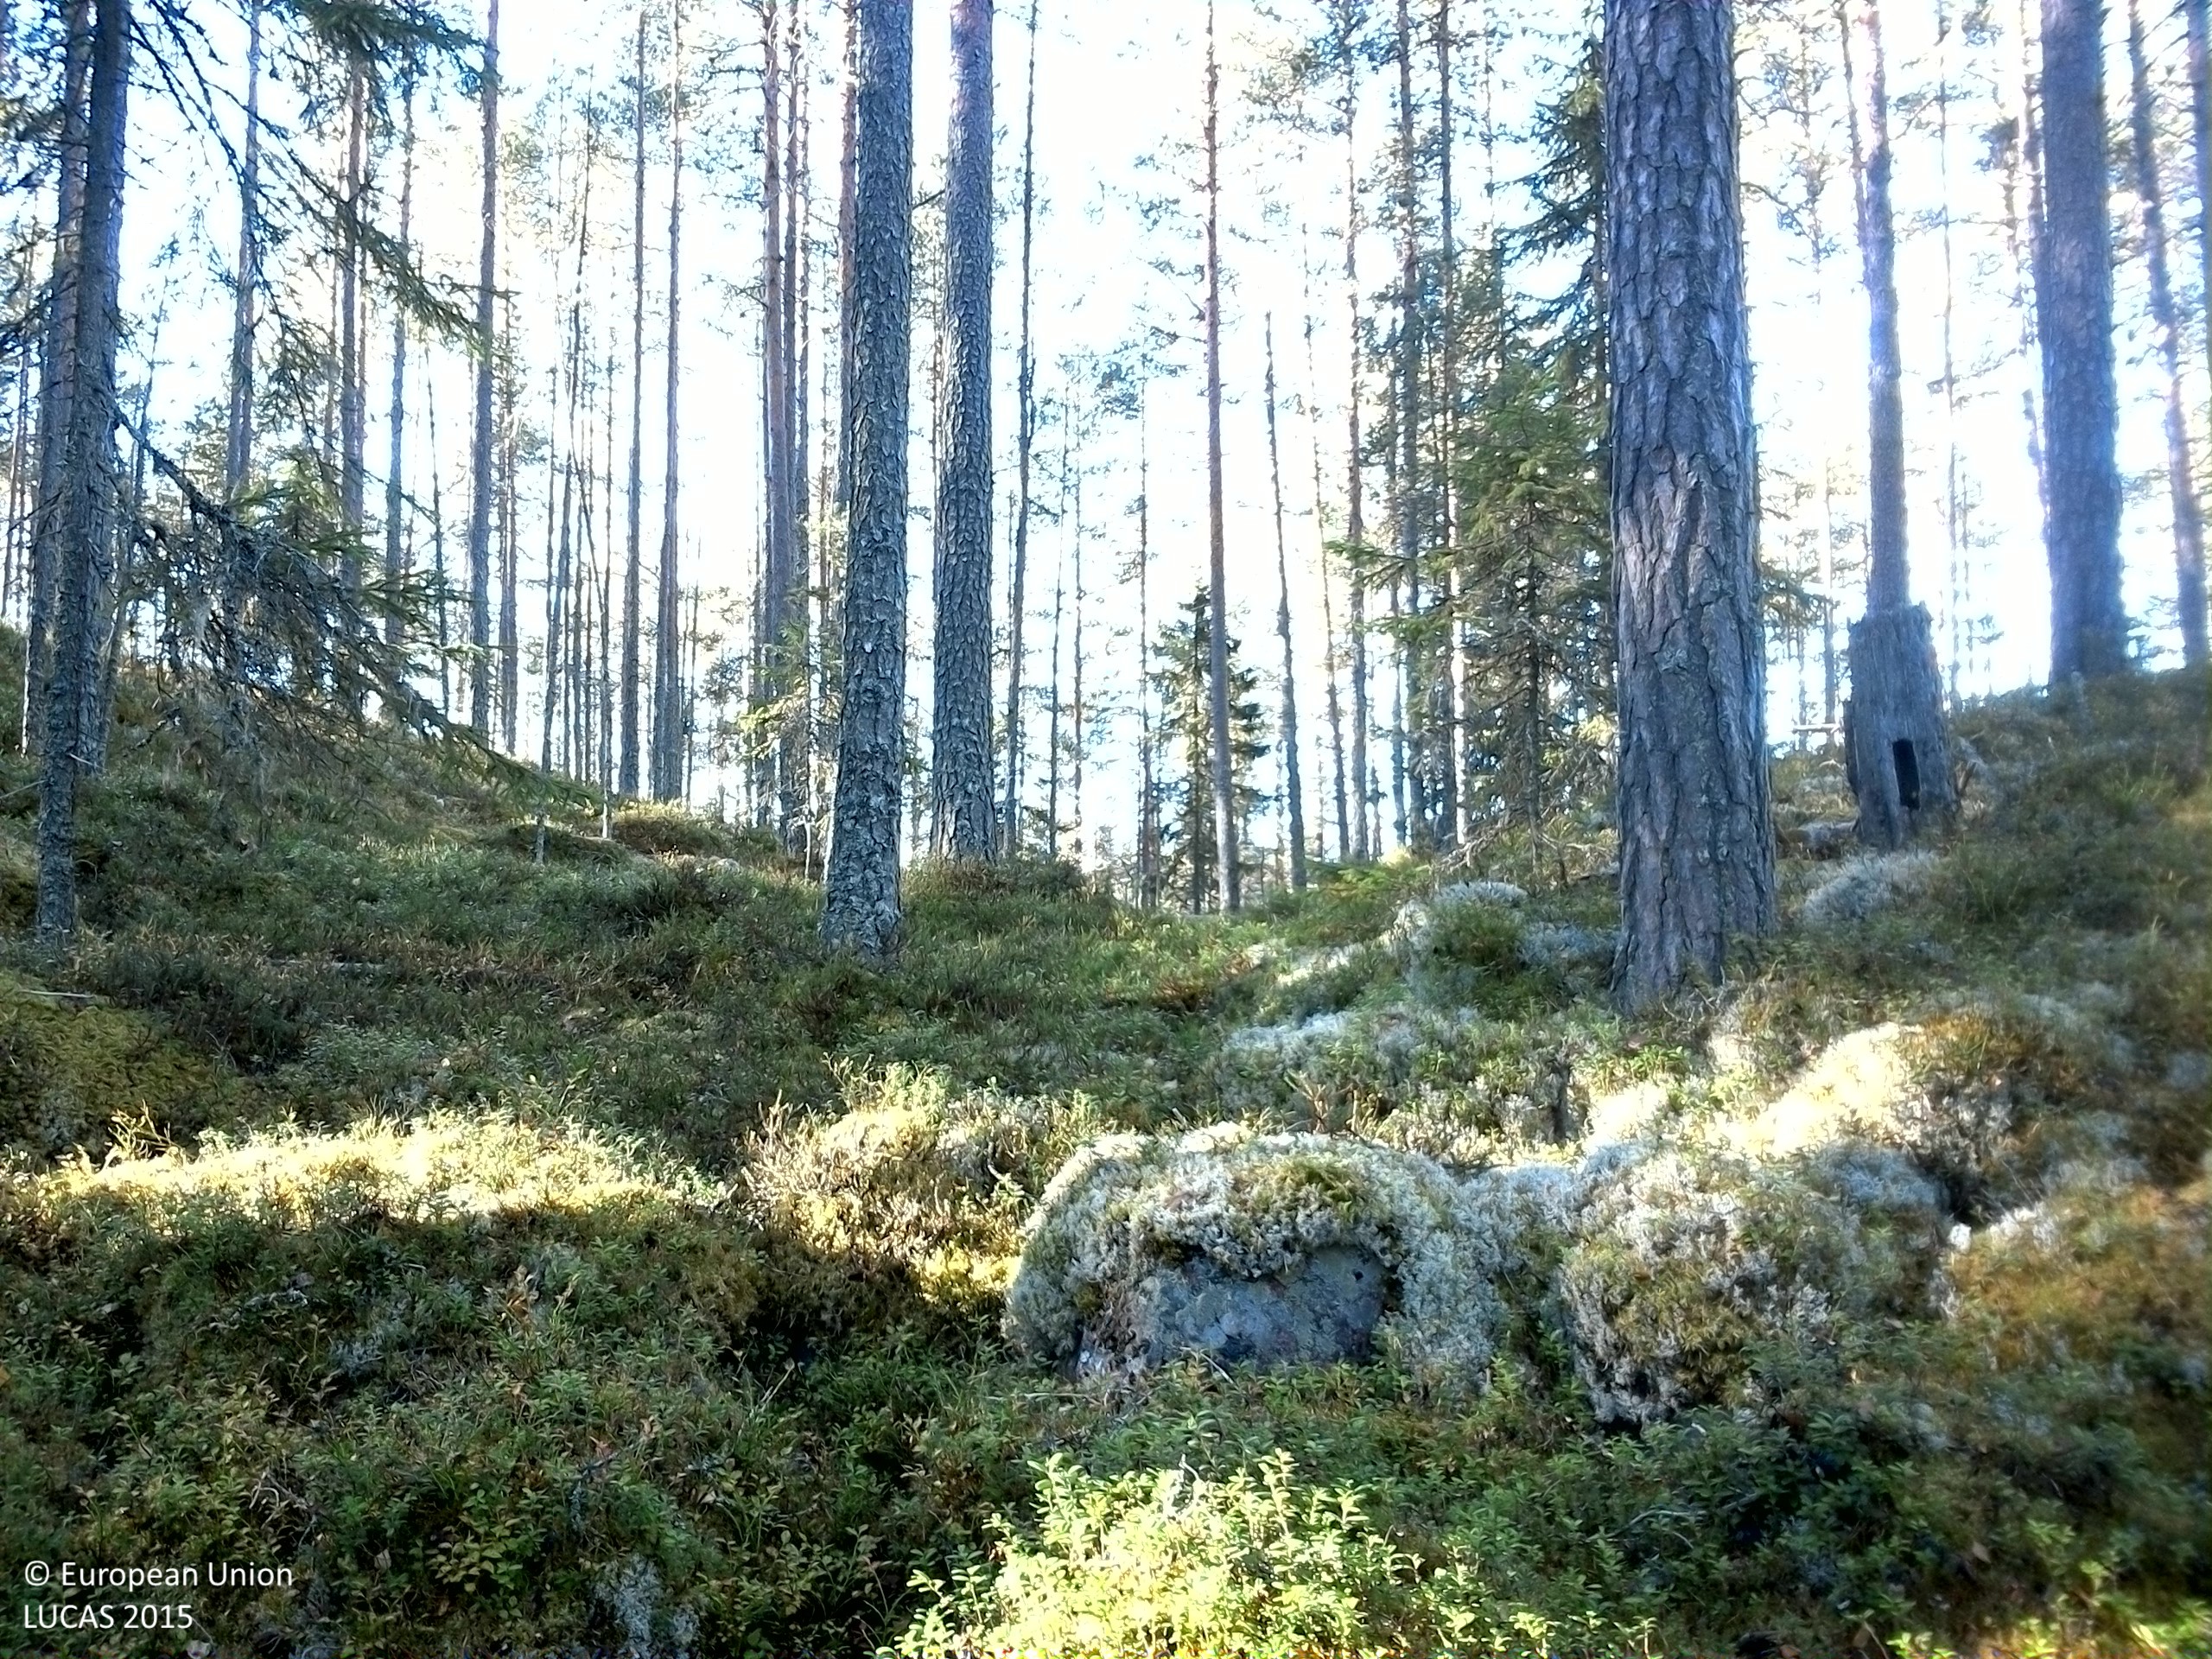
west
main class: Woodland
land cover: Pine dominated coniferous woodland
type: boreal forest
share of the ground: > 75 %
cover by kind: coniferous forest trees 75 %, shrubs 15 %, lichens and mosses 10 %
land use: Forestry
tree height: > 5 m
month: October
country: SE
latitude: 61.1427
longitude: 14.3143
